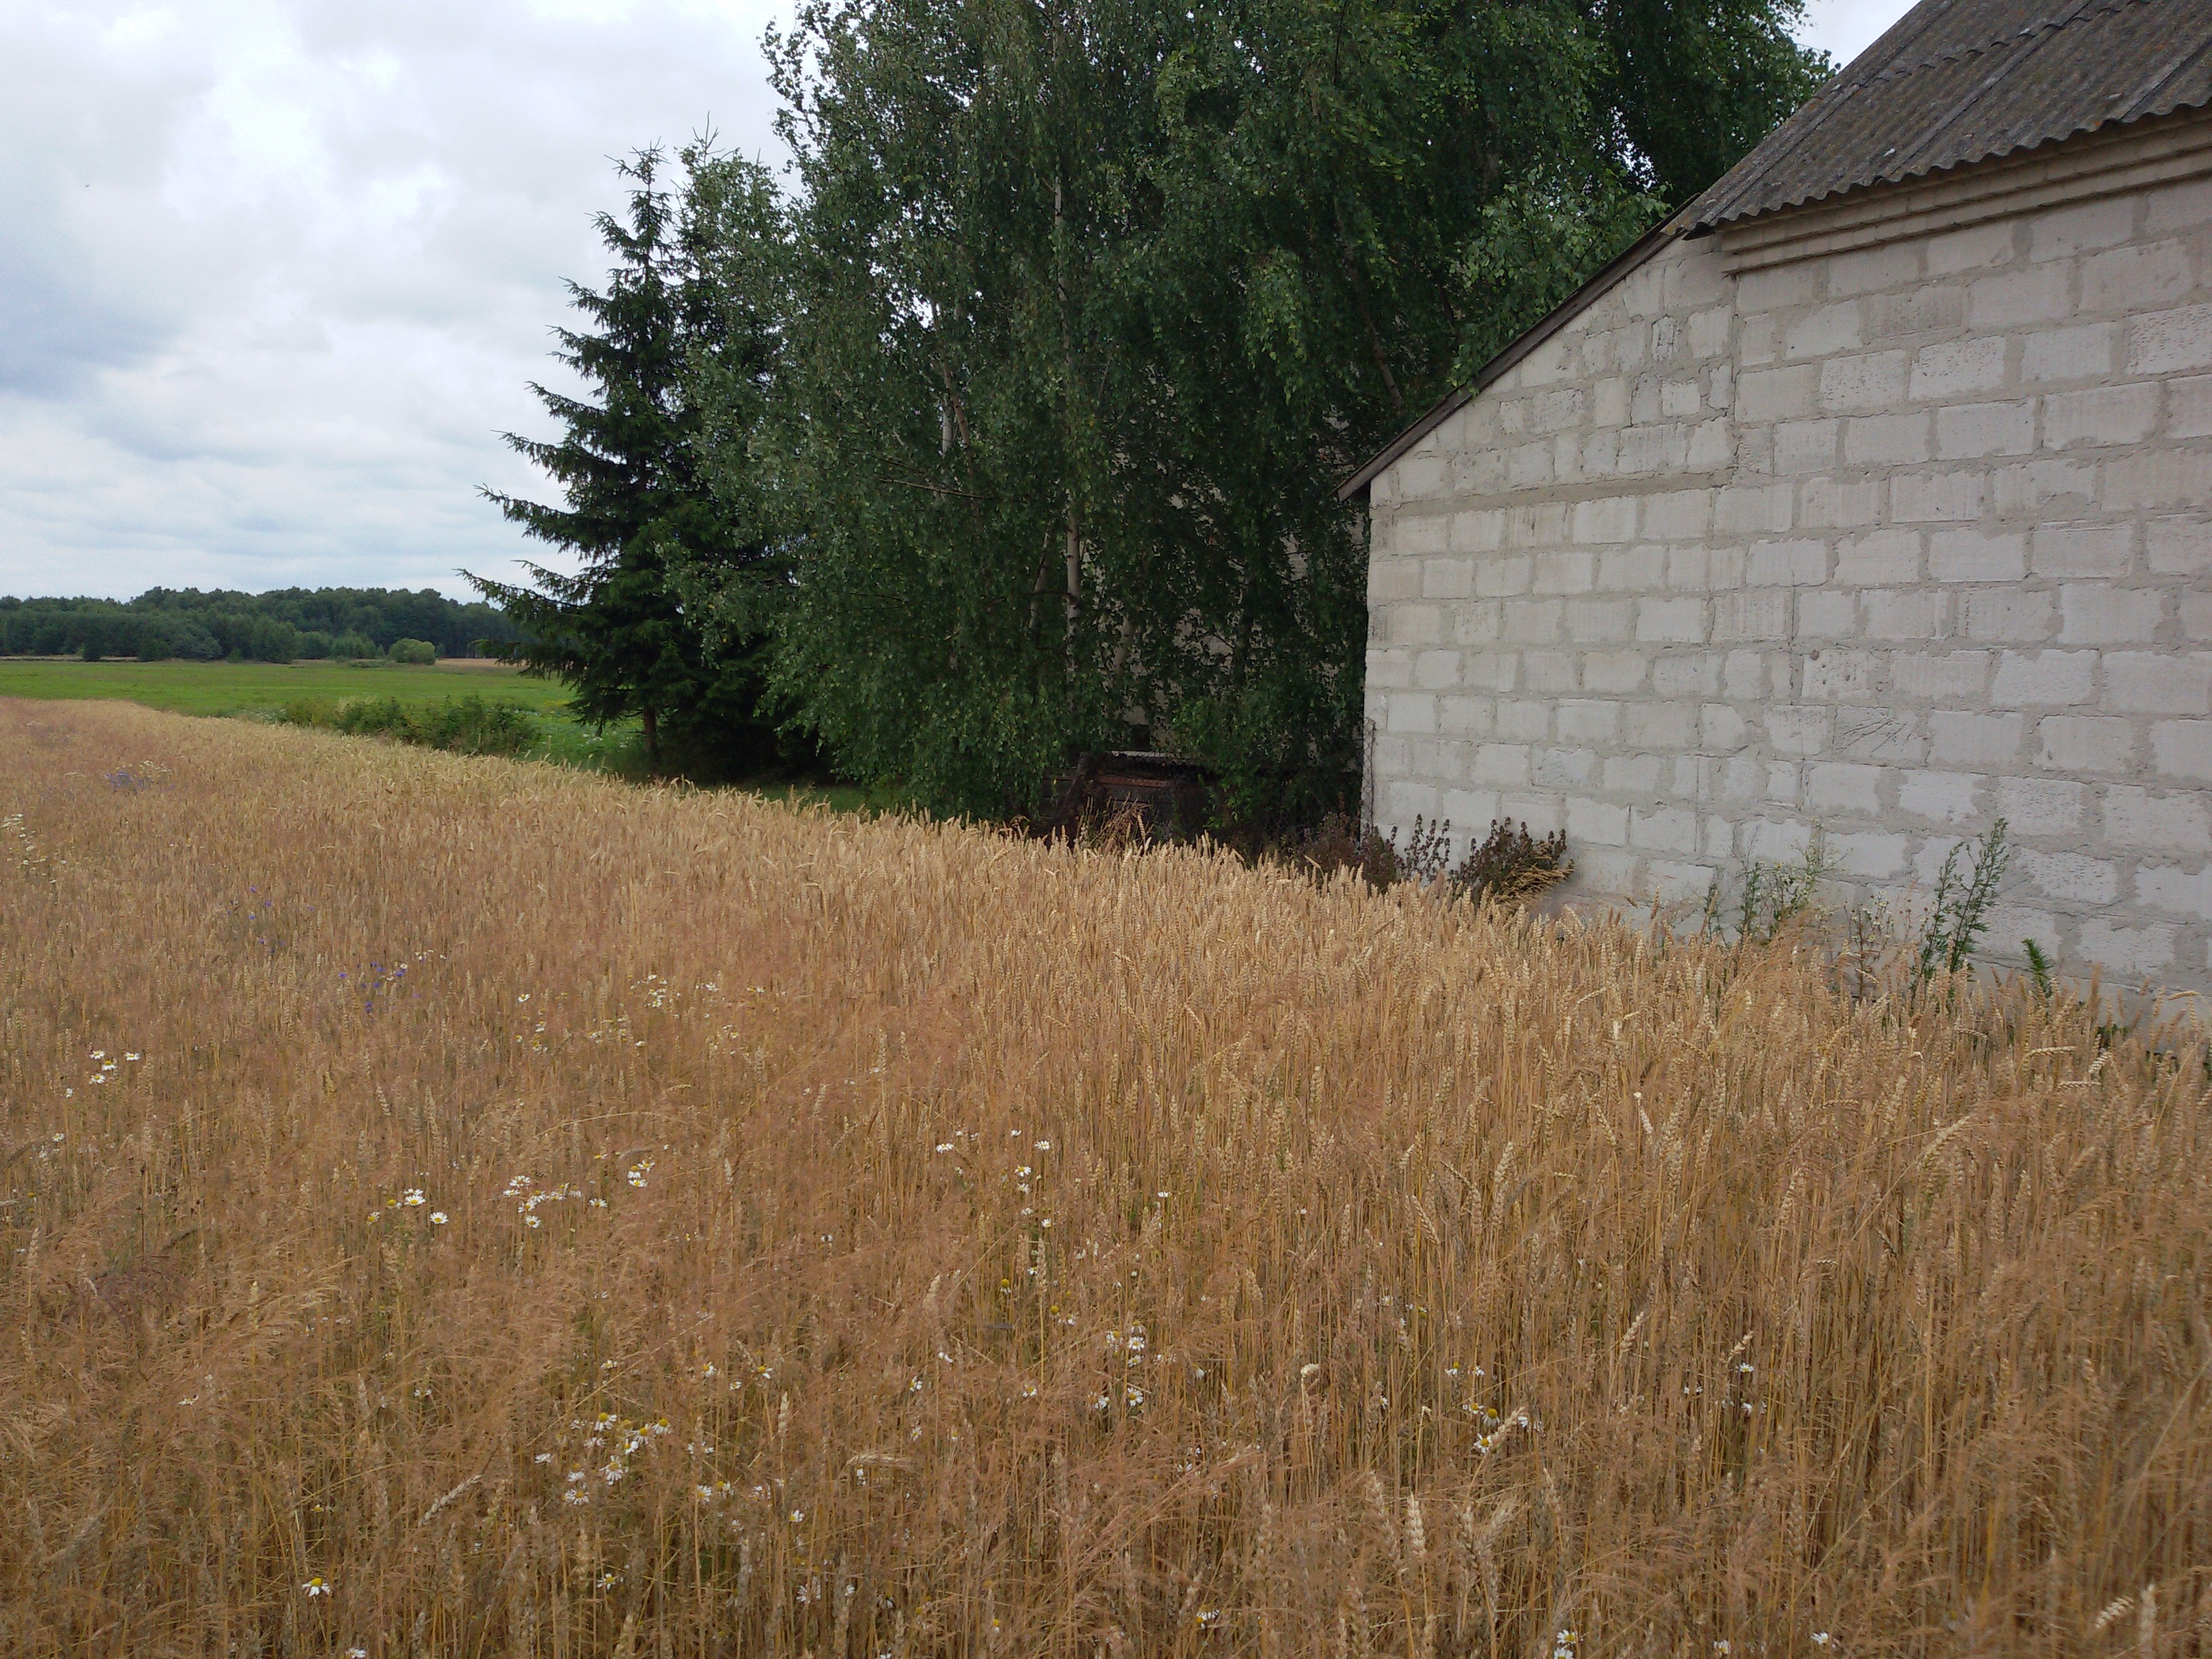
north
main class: Cropland
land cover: Common wheat
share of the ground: > 75 %
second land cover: Spontaneously vegetated surfaces
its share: 25 - 50 %
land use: Agriculture (excluding fallow land and kitchen gardens)
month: July
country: PL
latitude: 51.8351
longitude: 22.8876
